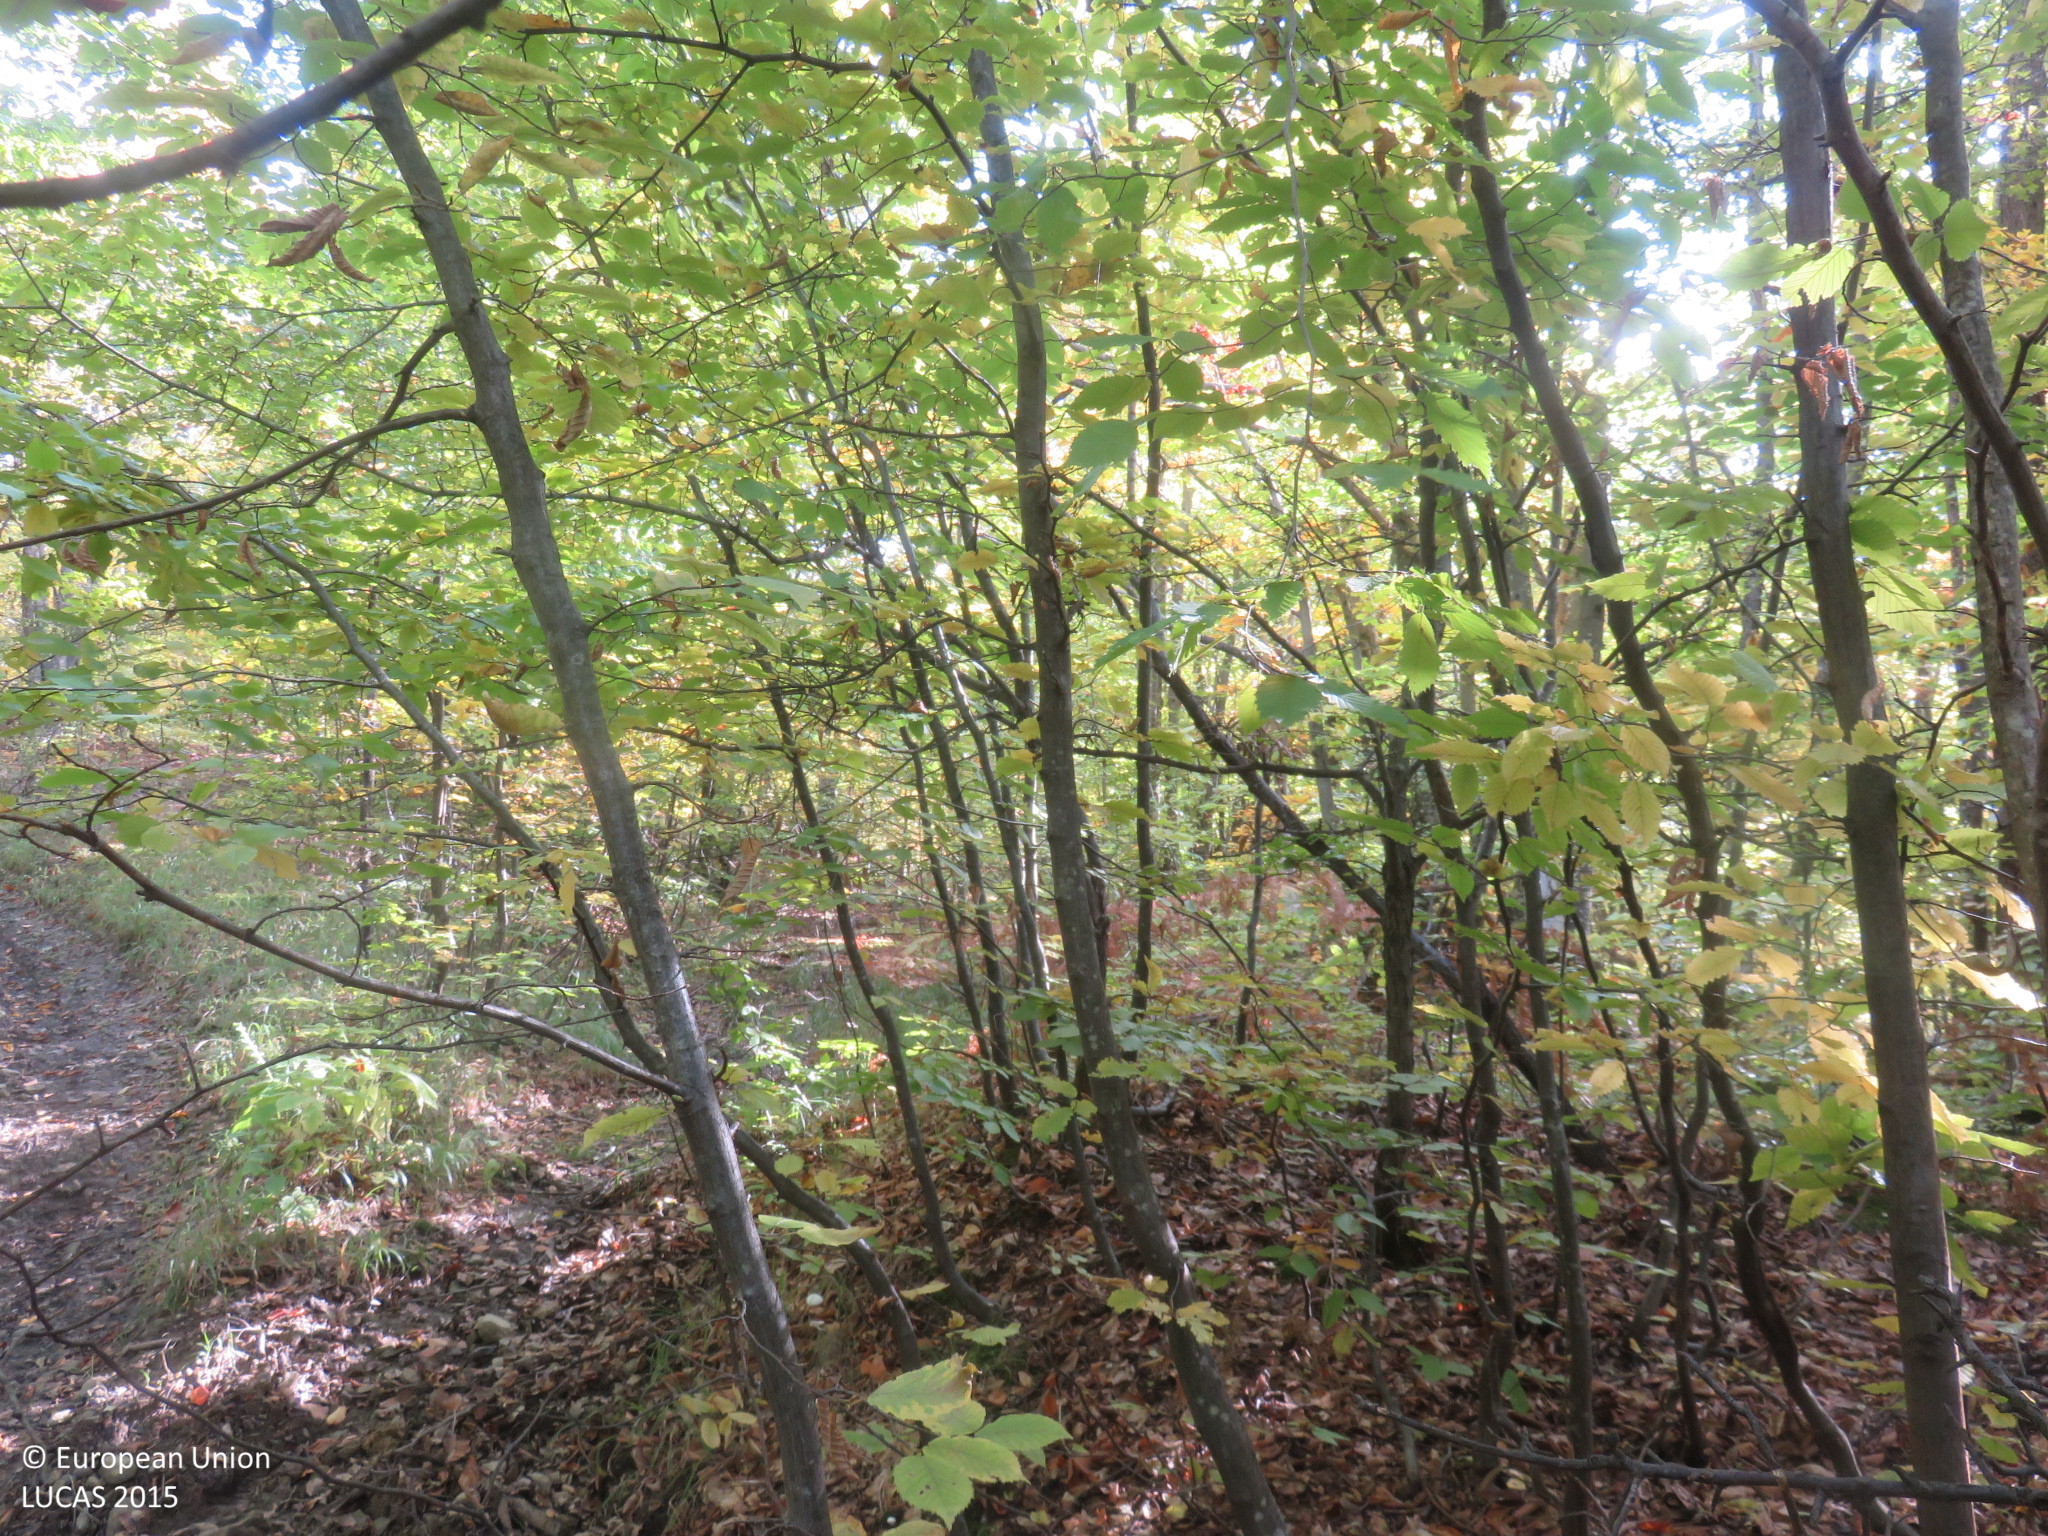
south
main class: Woodland
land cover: Broadleaved woodland
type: beech forest
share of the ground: > 75 %
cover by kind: broadleaved forest trees 95 %, shrubs 5 %
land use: Forestry
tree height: > 5 m
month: October
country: BG
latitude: 42.7855
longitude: 24.9393
